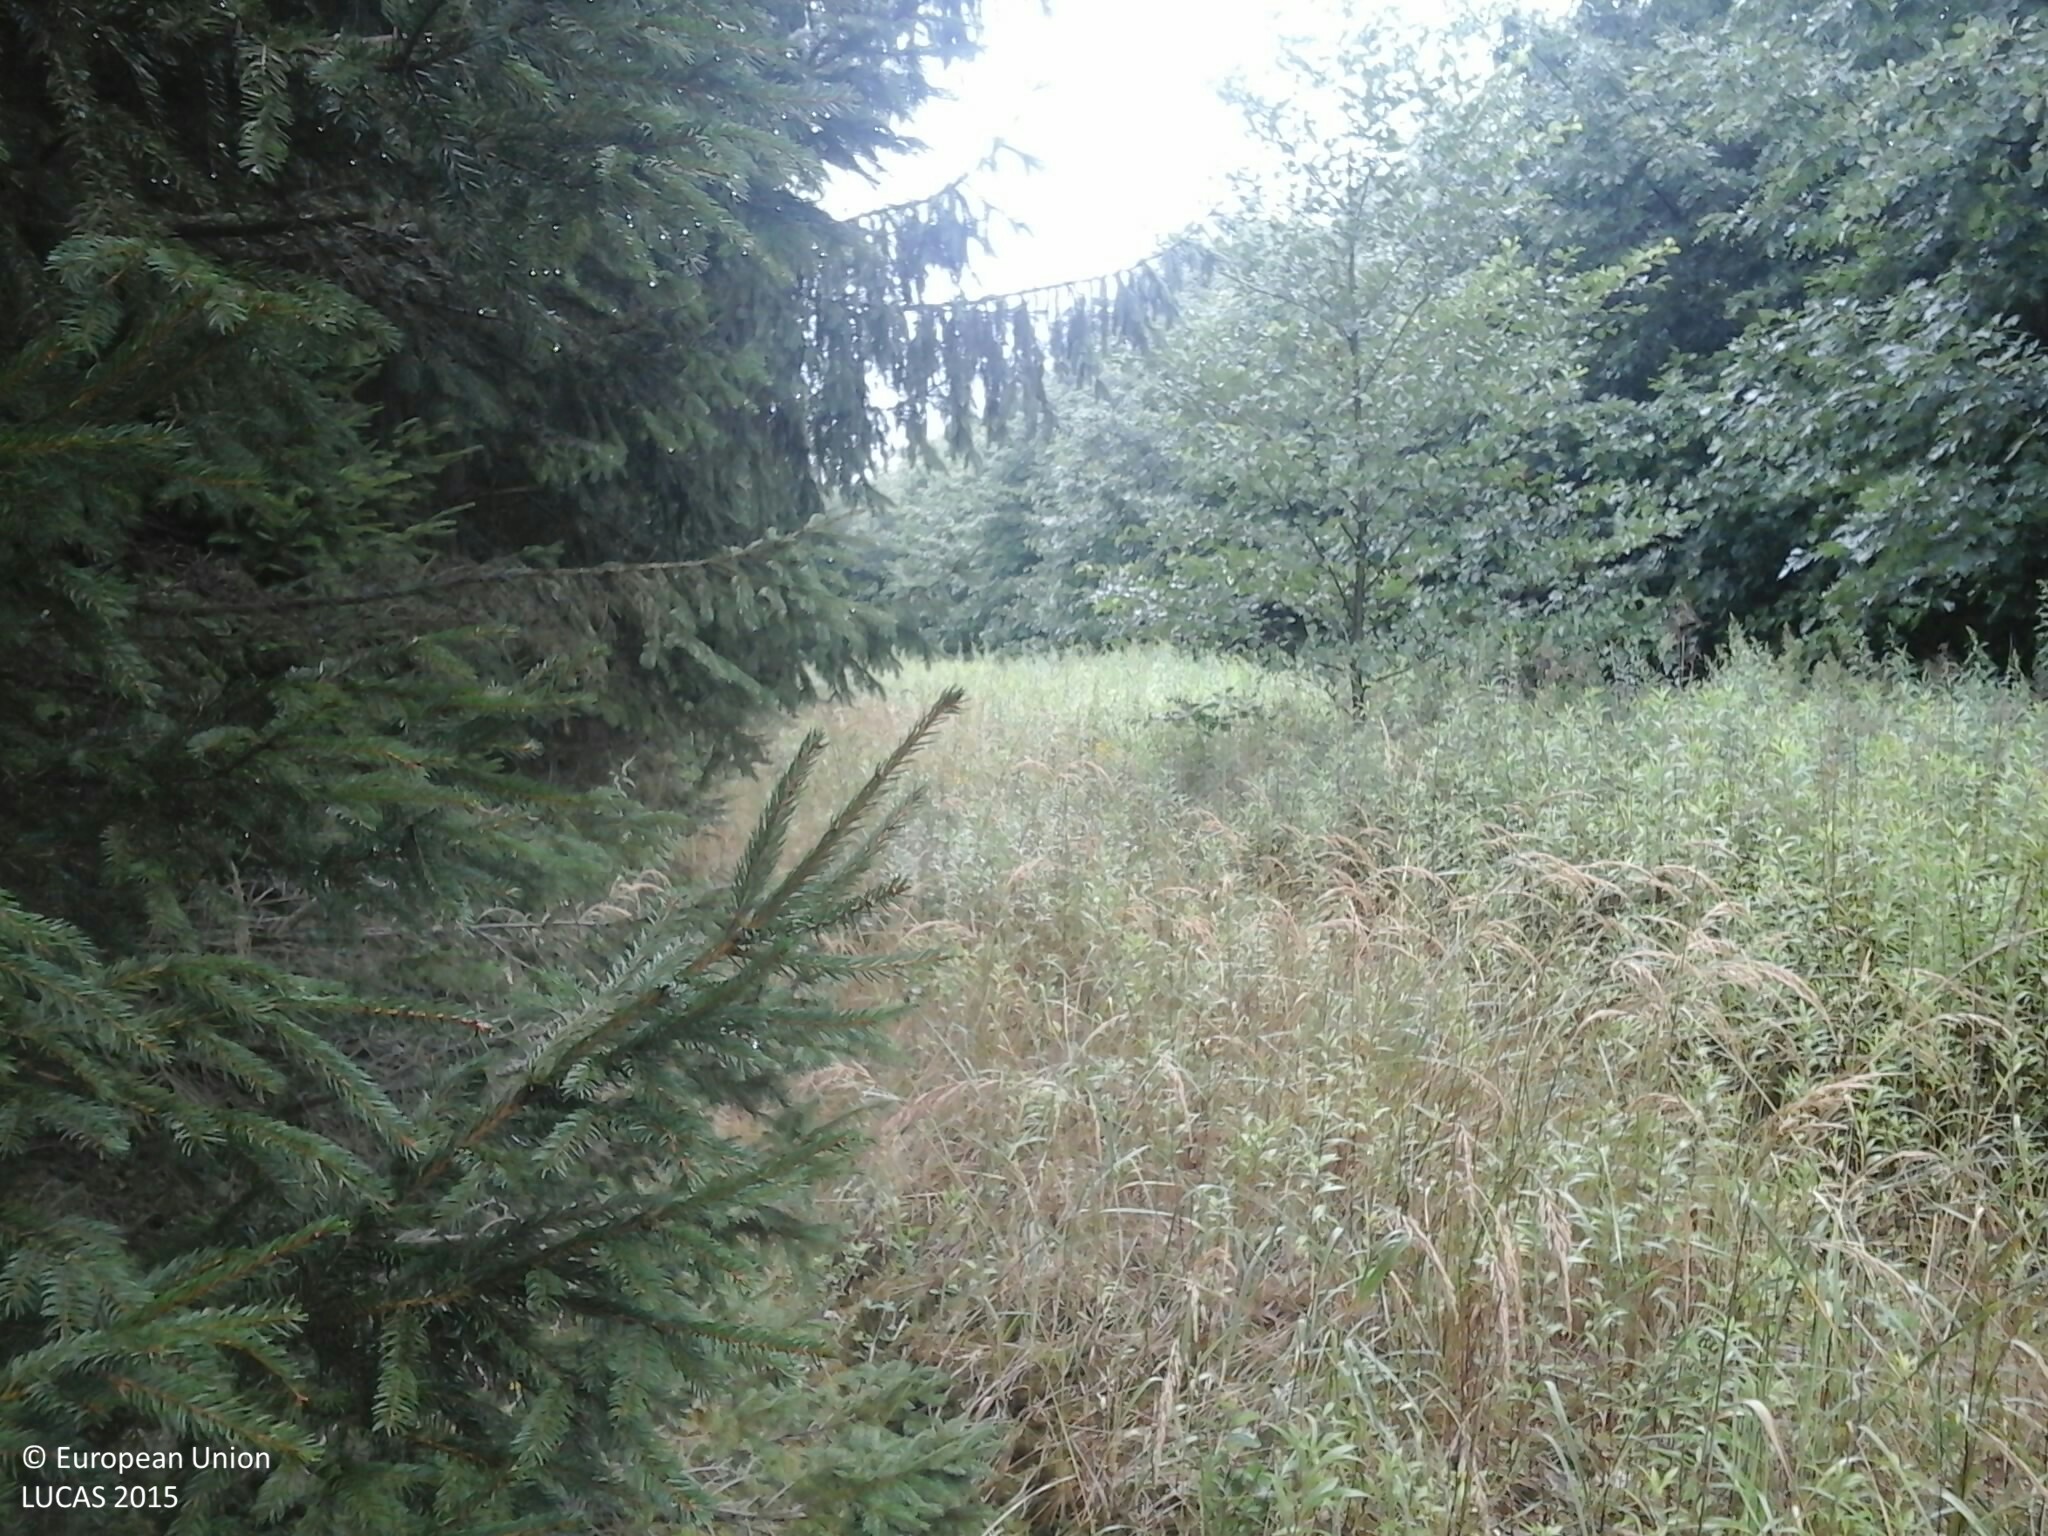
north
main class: Woodland
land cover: Spruce dominated coniferous woodland
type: hemiboreal forest and nemoral coniferous forest and mixed broadleaved-coniferous forest
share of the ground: > 75 %
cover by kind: coniferous forest trees 80 %, herbaceous plants 20 %
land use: Forestry
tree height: > 5 m
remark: Nursery
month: July
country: HU
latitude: 46.8583
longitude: 16.4948
